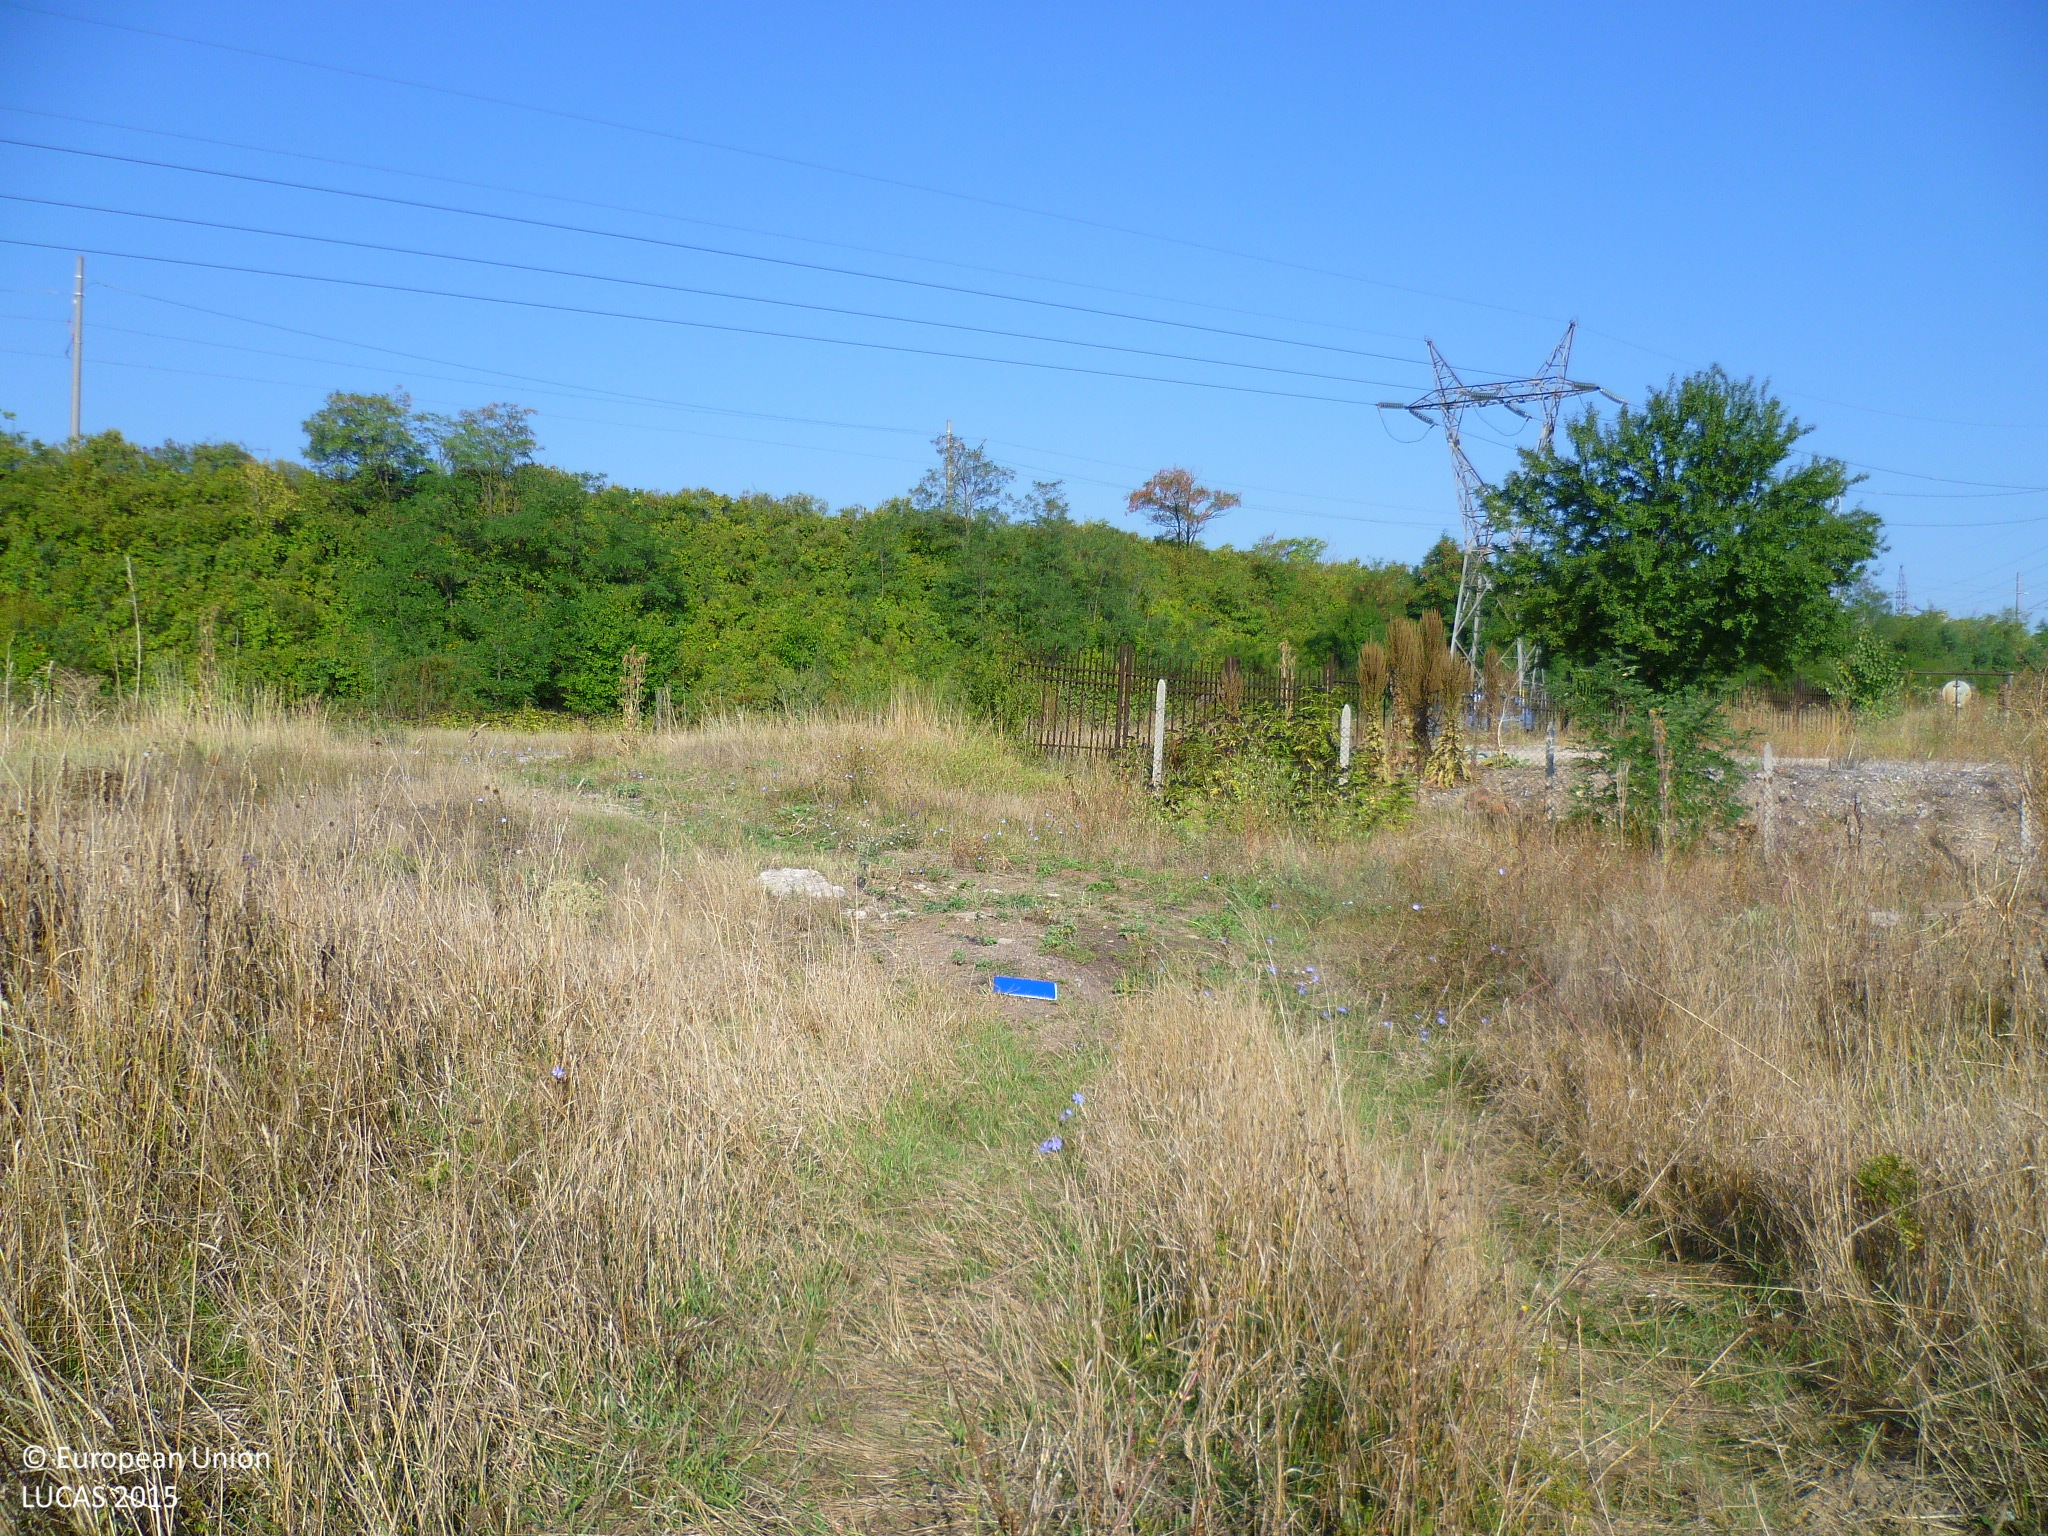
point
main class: Grassland
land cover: Grassland without tree/shrub cover
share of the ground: > 75 %
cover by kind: herbaceous plants 80 %, unconsolidated bare surface 20 %
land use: Abandoned areas
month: September
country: BG
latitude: 42.6291
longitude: 23.0403
